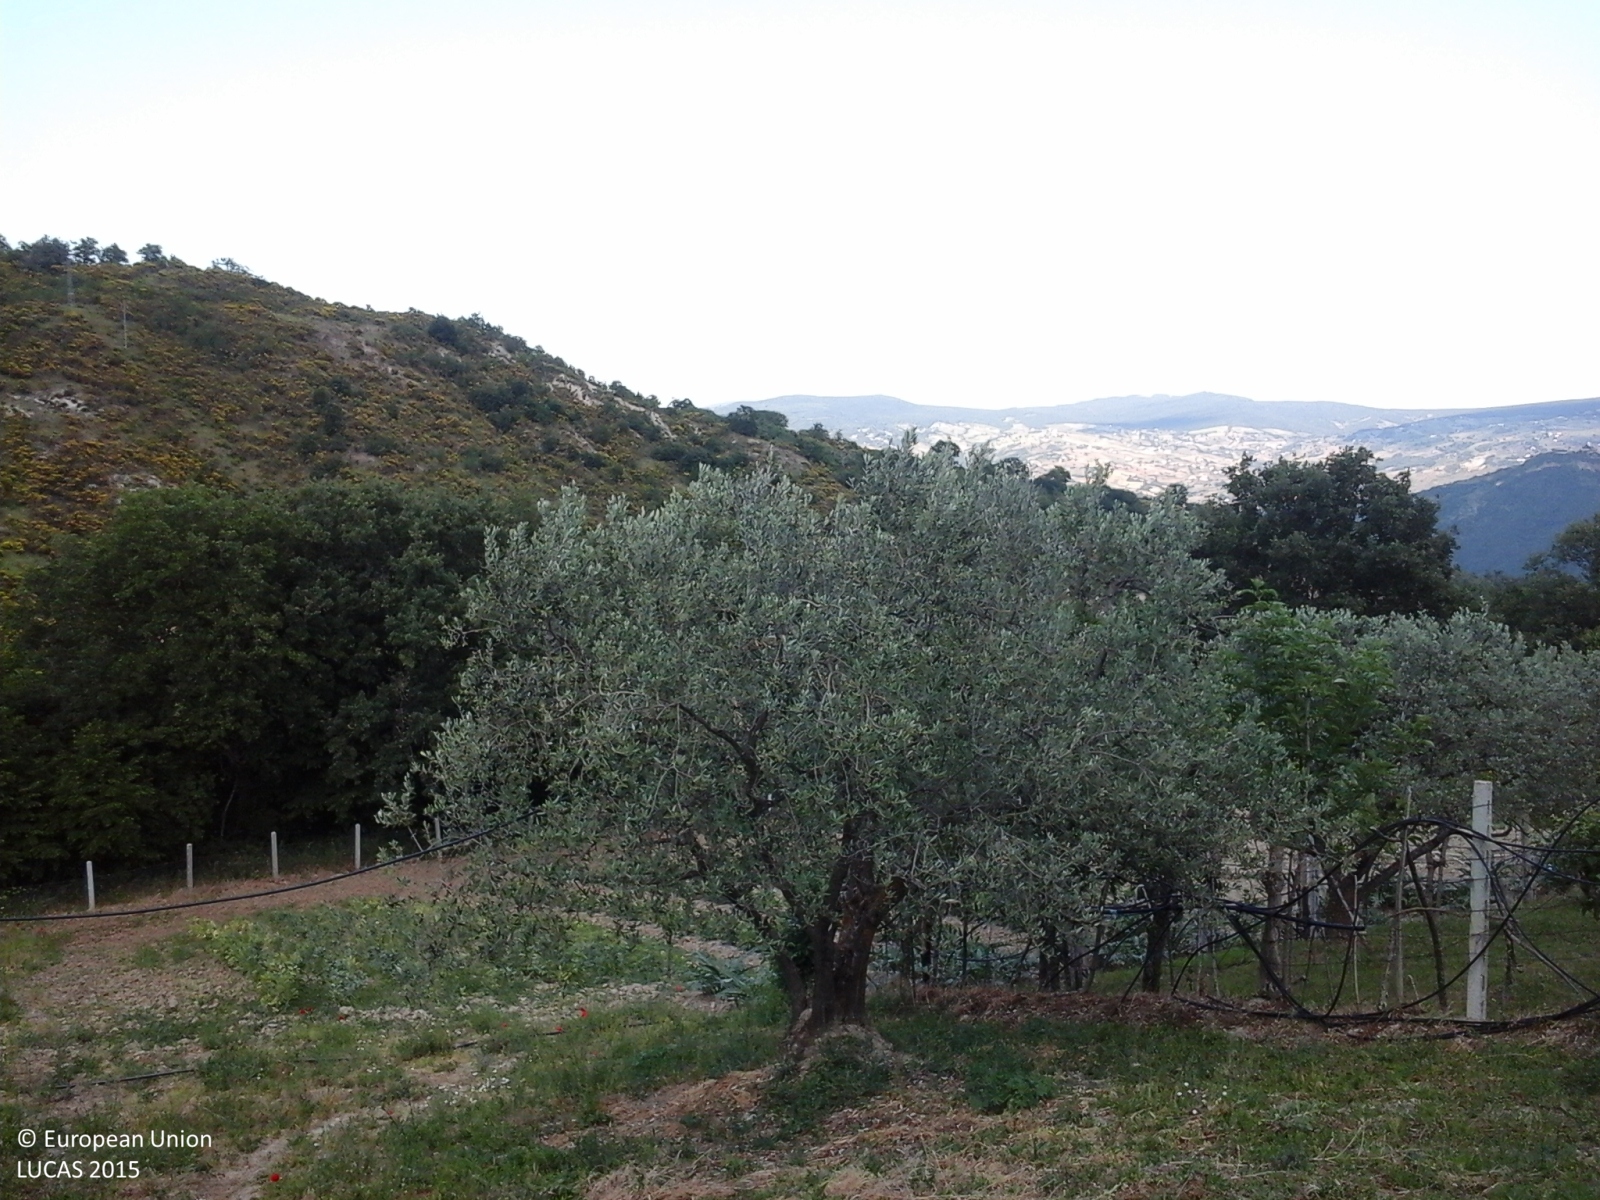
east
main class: Cropland
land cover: Olive groves
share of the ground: 25 - 50 %
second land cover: Spontaneously vegetated surfaces
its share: 25 - 50 %
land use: Agriculture (excluding fallow land and kitchen gardens)
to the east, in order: Olive groves; Spontaneously vegetated surfaces; Olive groves; Other fresh vegetables; Tomatoes; Fences; Broadleaved woodland; Paved roads, cycling and walking lanes; Shrubland with sparse tree cover; Rivers and streams; Shrubland with sparse tree cover
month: June
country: IT
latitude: 41.7943
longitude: 14.4977
